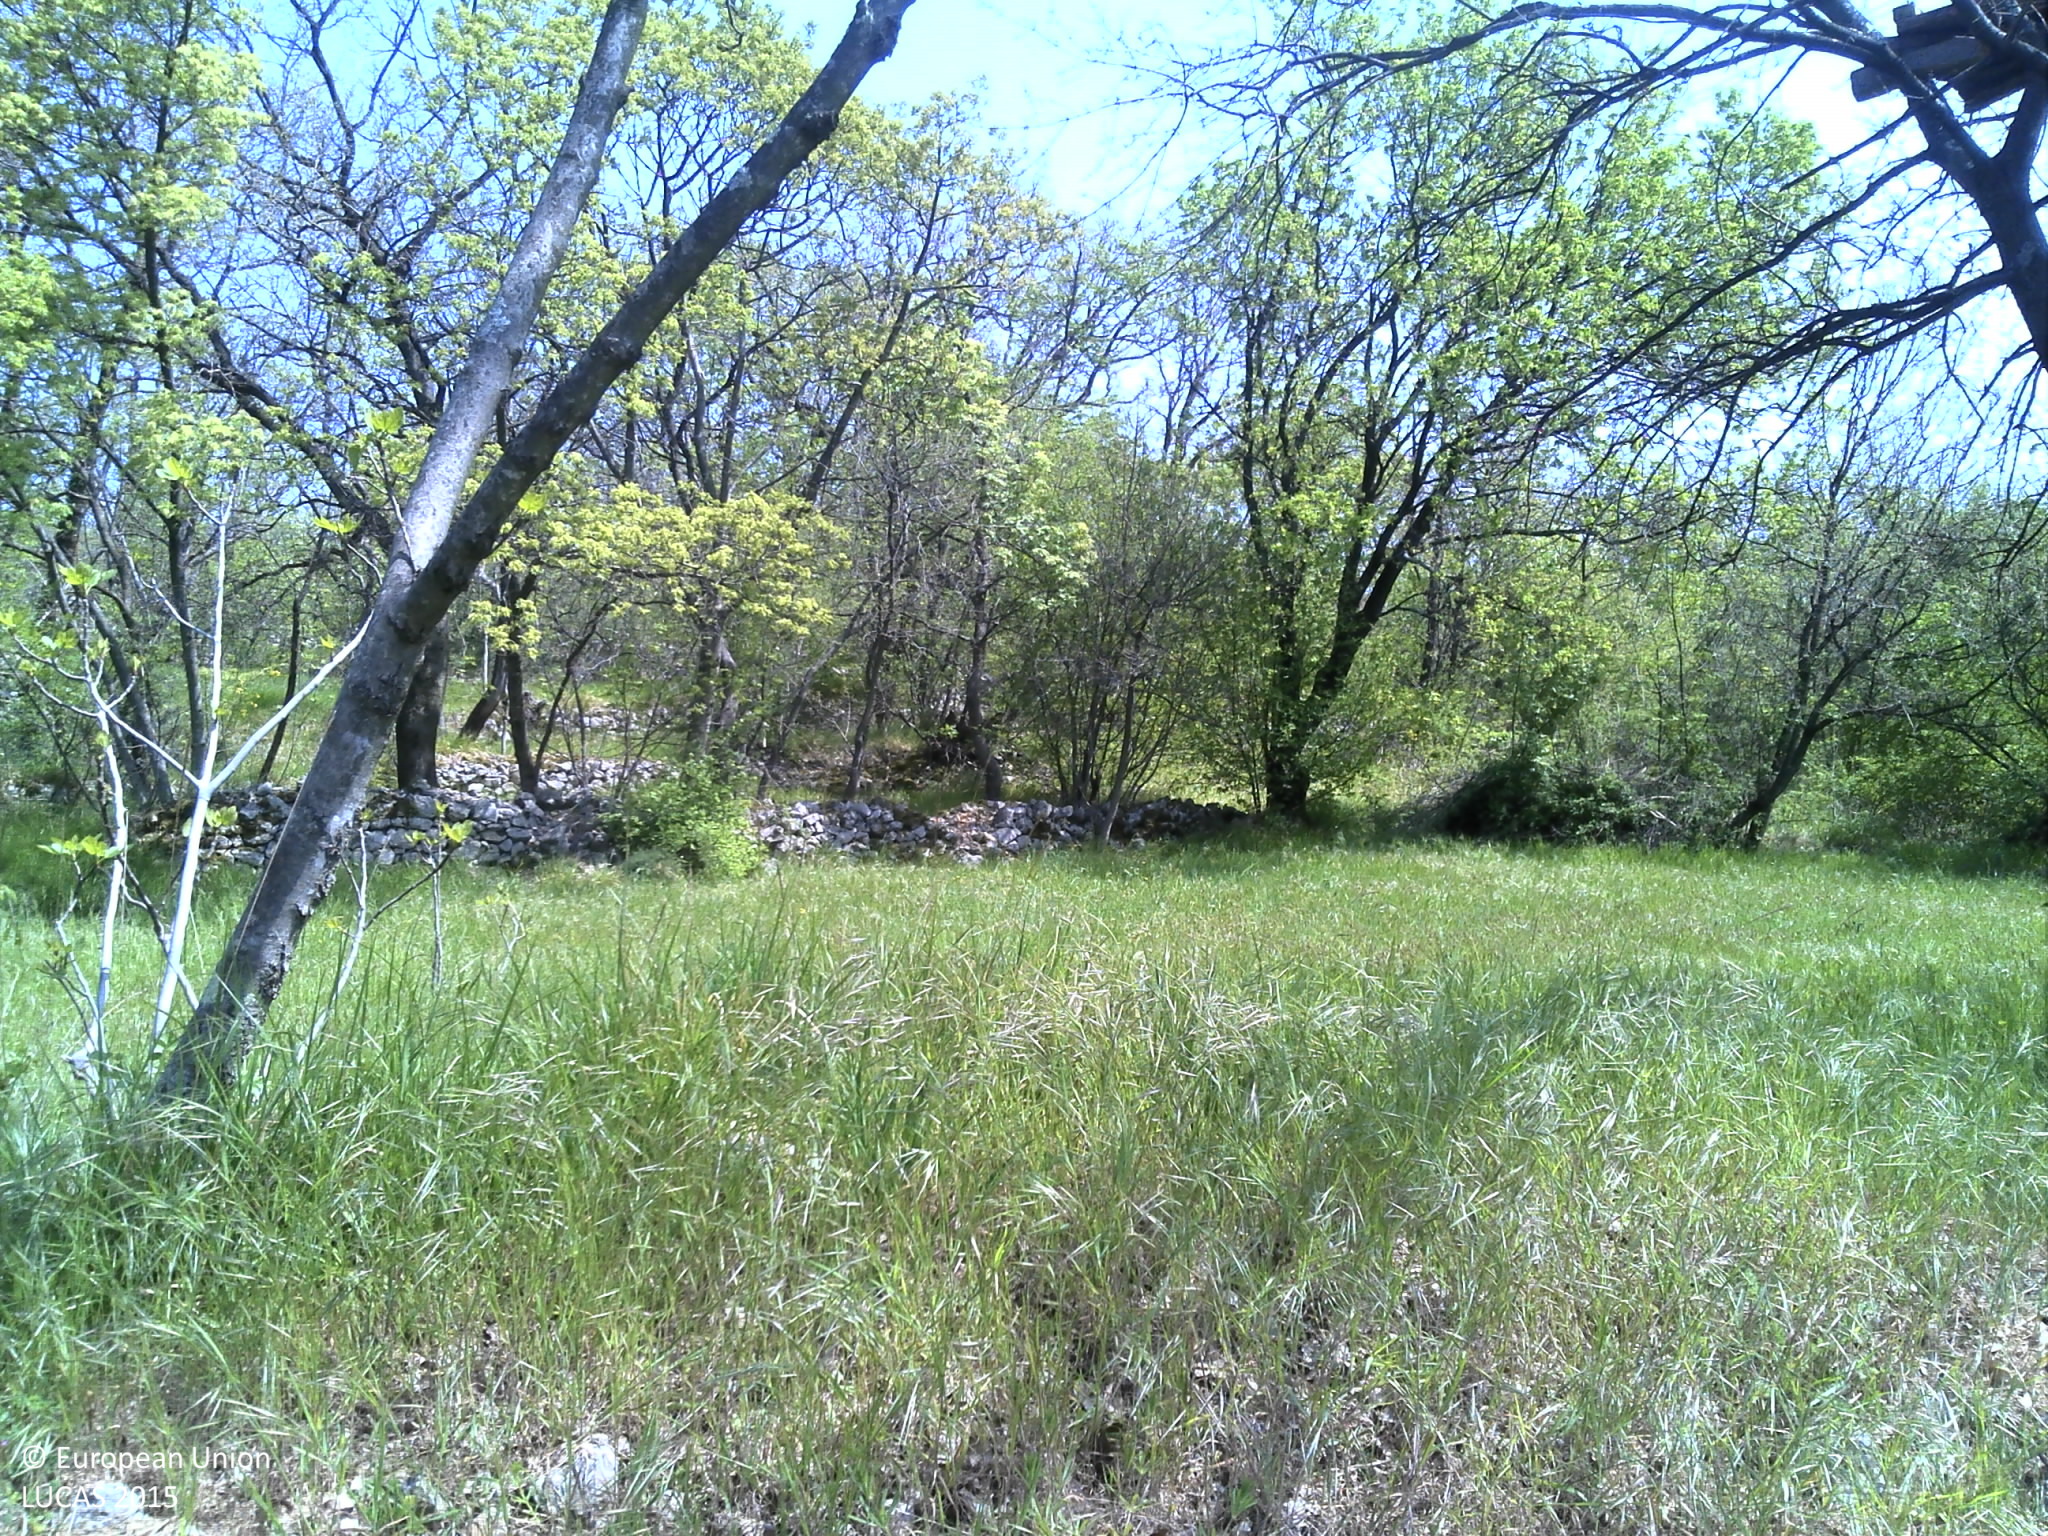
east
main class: Grassland
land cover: Grassland with sparse tree/shrub cover
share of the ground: > 75 %
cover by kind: herbaceous plants 70 %, shrubs 10 %, broadleaved forest trees 5 %
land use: Abandoned areas
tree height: < 5 m
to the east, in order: Grassland with sparse tree/shrub cover; Dry stone walls; Grassland with sparse tree/shrub cover; Broadleaved woodland; Tracks; Broadleaved woodland; Electric lines; Dry stone walls; Grassland with sparse tree/shrub cover; Dry stone walls; Electric lines; Broadleaved woodland; Rocks and stones; Broadleaved woodland
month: April
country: HR
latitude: 45.3162
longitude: 14.5489
